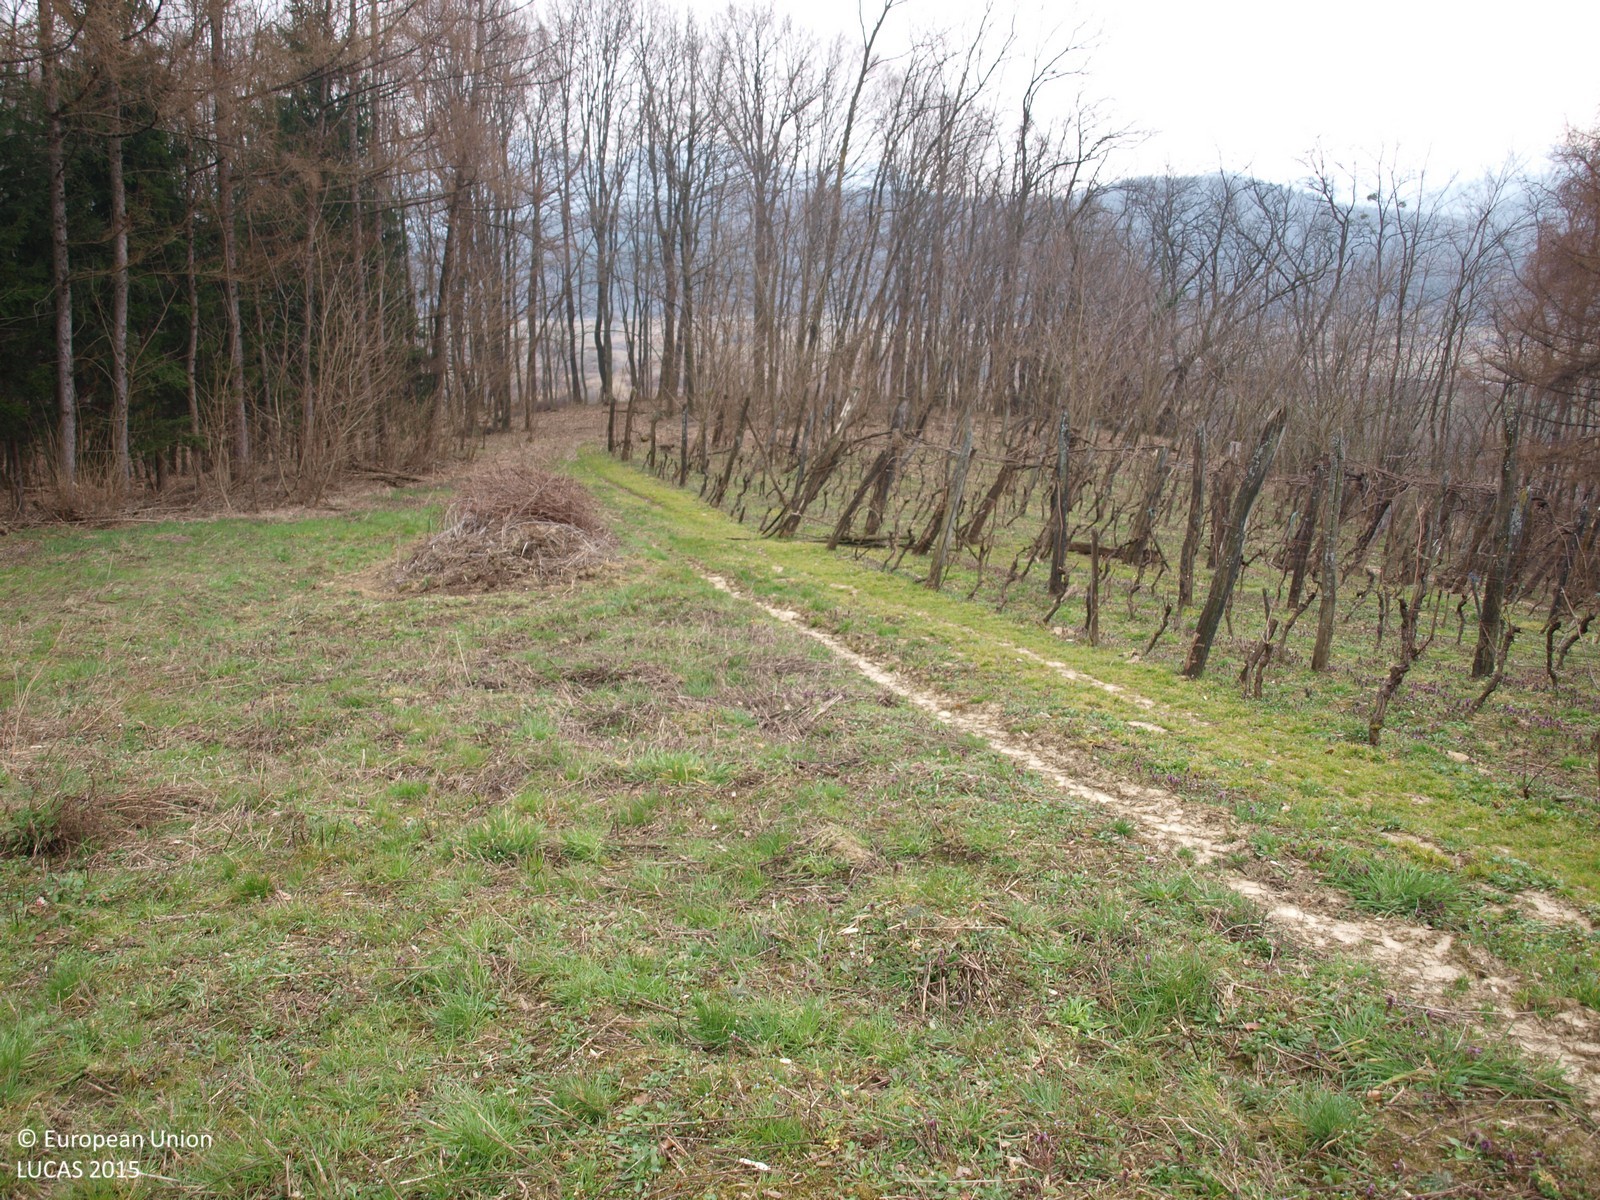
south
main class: Grassland
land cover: Grassland without tree/shrub cover
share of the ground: > 75 %
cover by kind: herbaceous plants 100 %
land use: Agriculture (excluding fallow land and kitchen gardens)
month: March
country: HR
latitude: 46.2264
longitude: 16.1840
